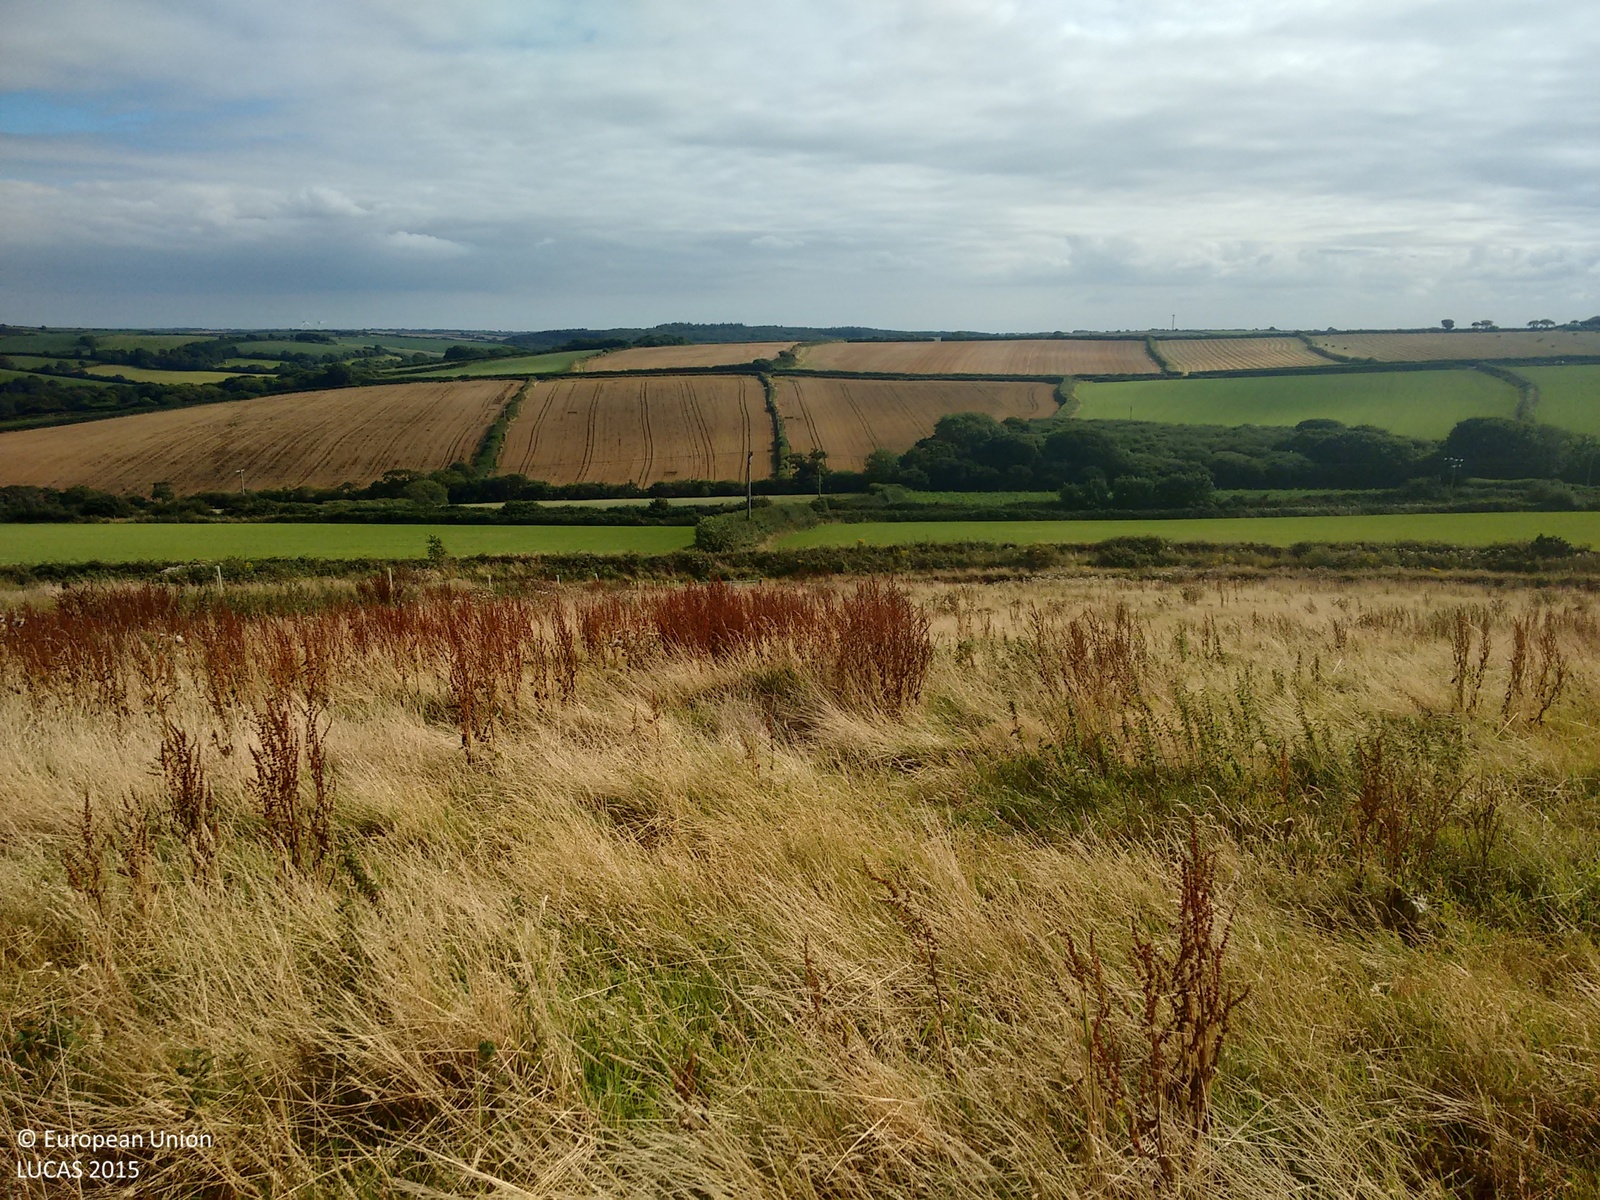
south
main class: Grassland
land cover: Spontaneously vegetated surfaces
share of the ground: > 75 %
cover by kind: herbaceous plants 100 %
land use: Semi-natural and natural areas not in use
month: August
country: GB
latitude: 50.3488
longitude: -4.9118
